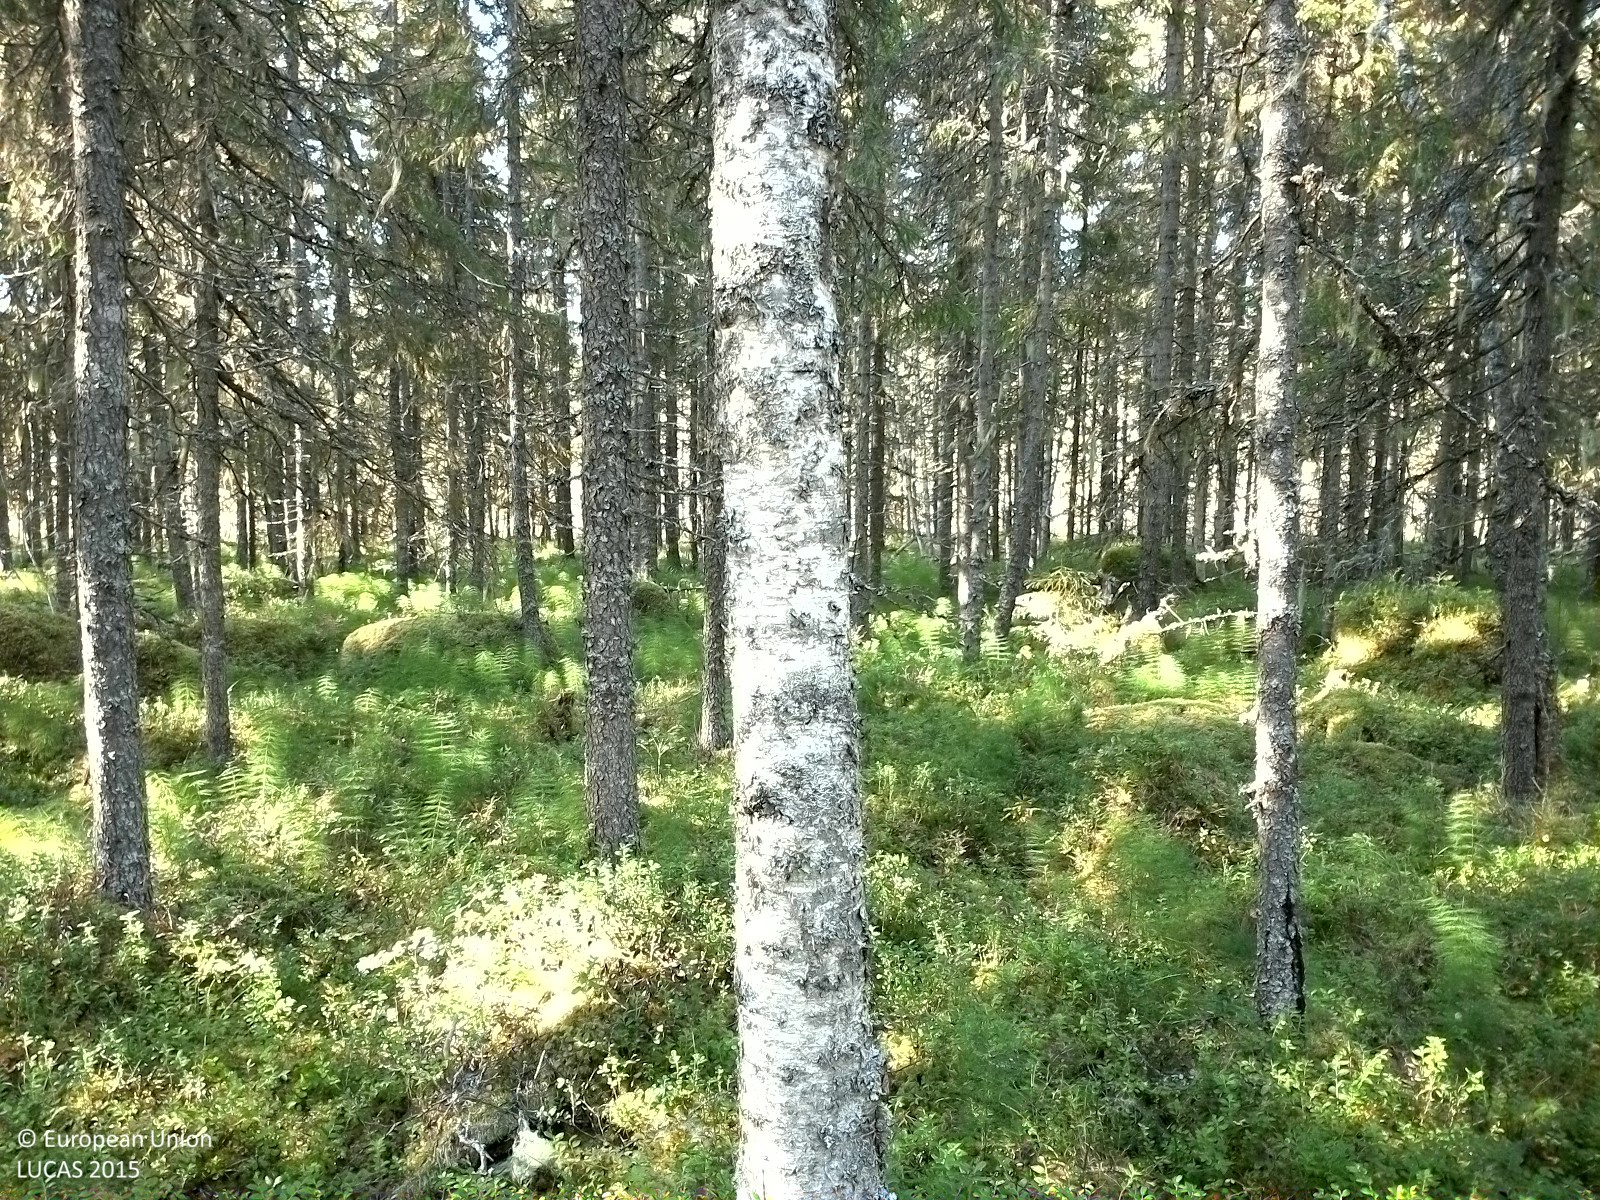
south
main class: Woodland
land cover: Spruce dominated coniferous woodland
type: boreal forest
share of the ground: 50 - 75 %
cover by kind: coniferous forest trees 50 %, shrubs 30 %, herbaceous plants 15 %, broadleaved forest trees 5 %
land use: Forestry
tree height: > 5 m
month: September
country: SE
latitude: 62.5609
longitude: 16.1064
